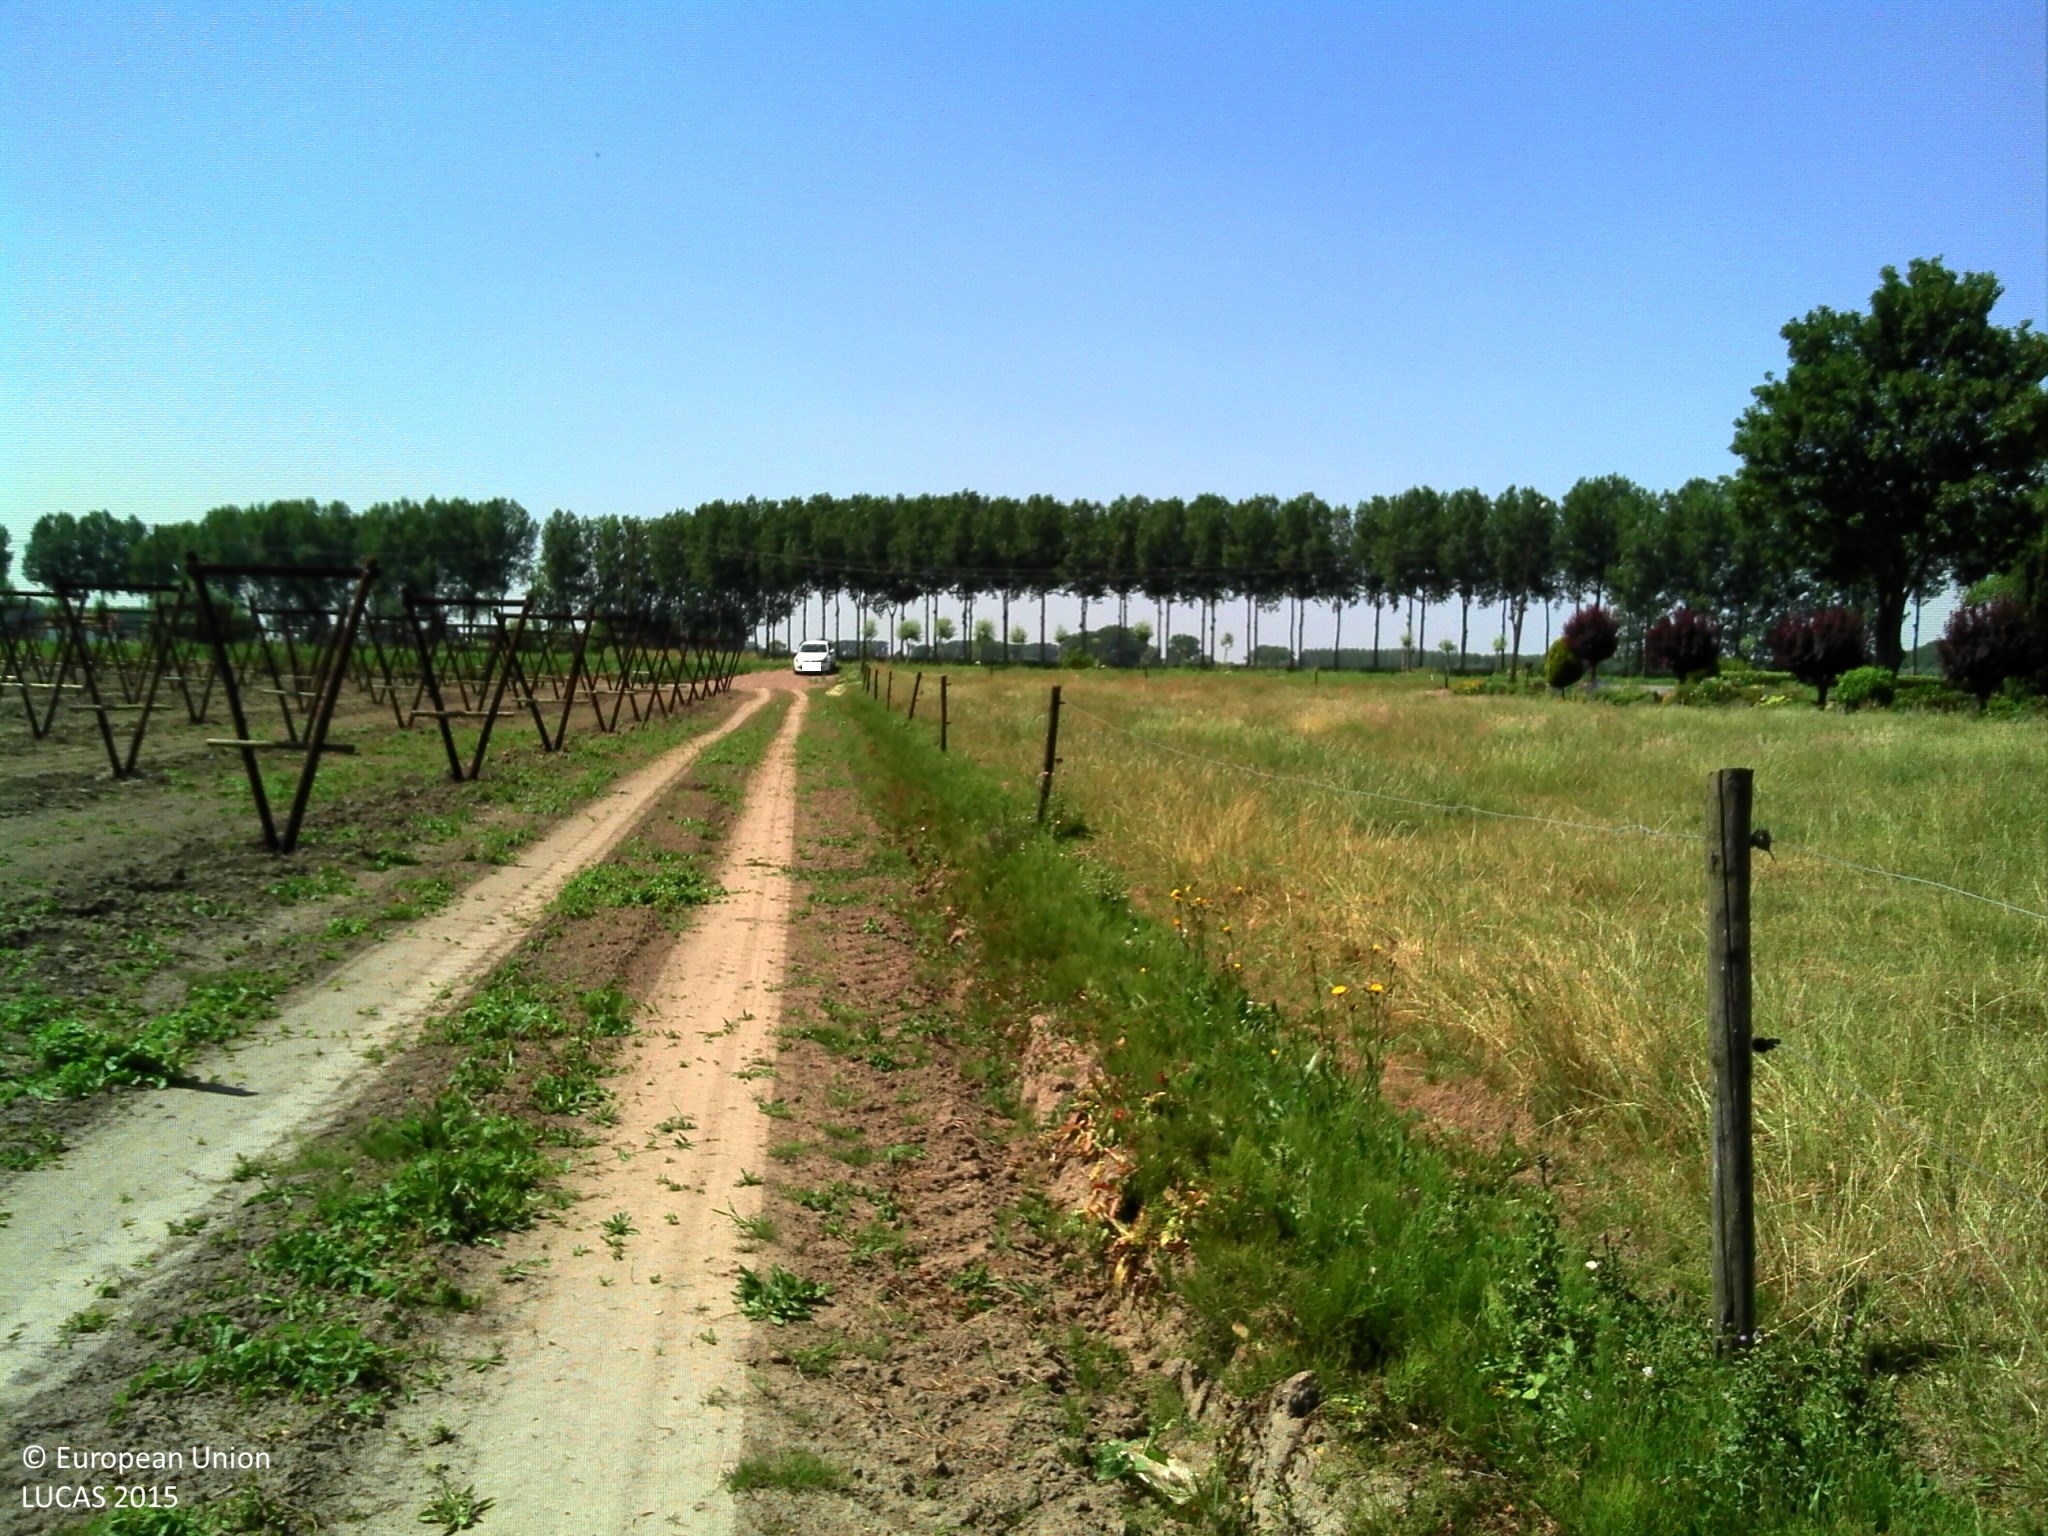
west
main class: Grassland
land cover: Grassland without tree/shrub cover
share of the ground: > 75 %
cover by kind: herbaceous plants 100 %
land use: Agriculture (excluding fallow land and kitchen gardens)
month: June
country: BE
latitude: 51.2398
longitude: 3.7624
